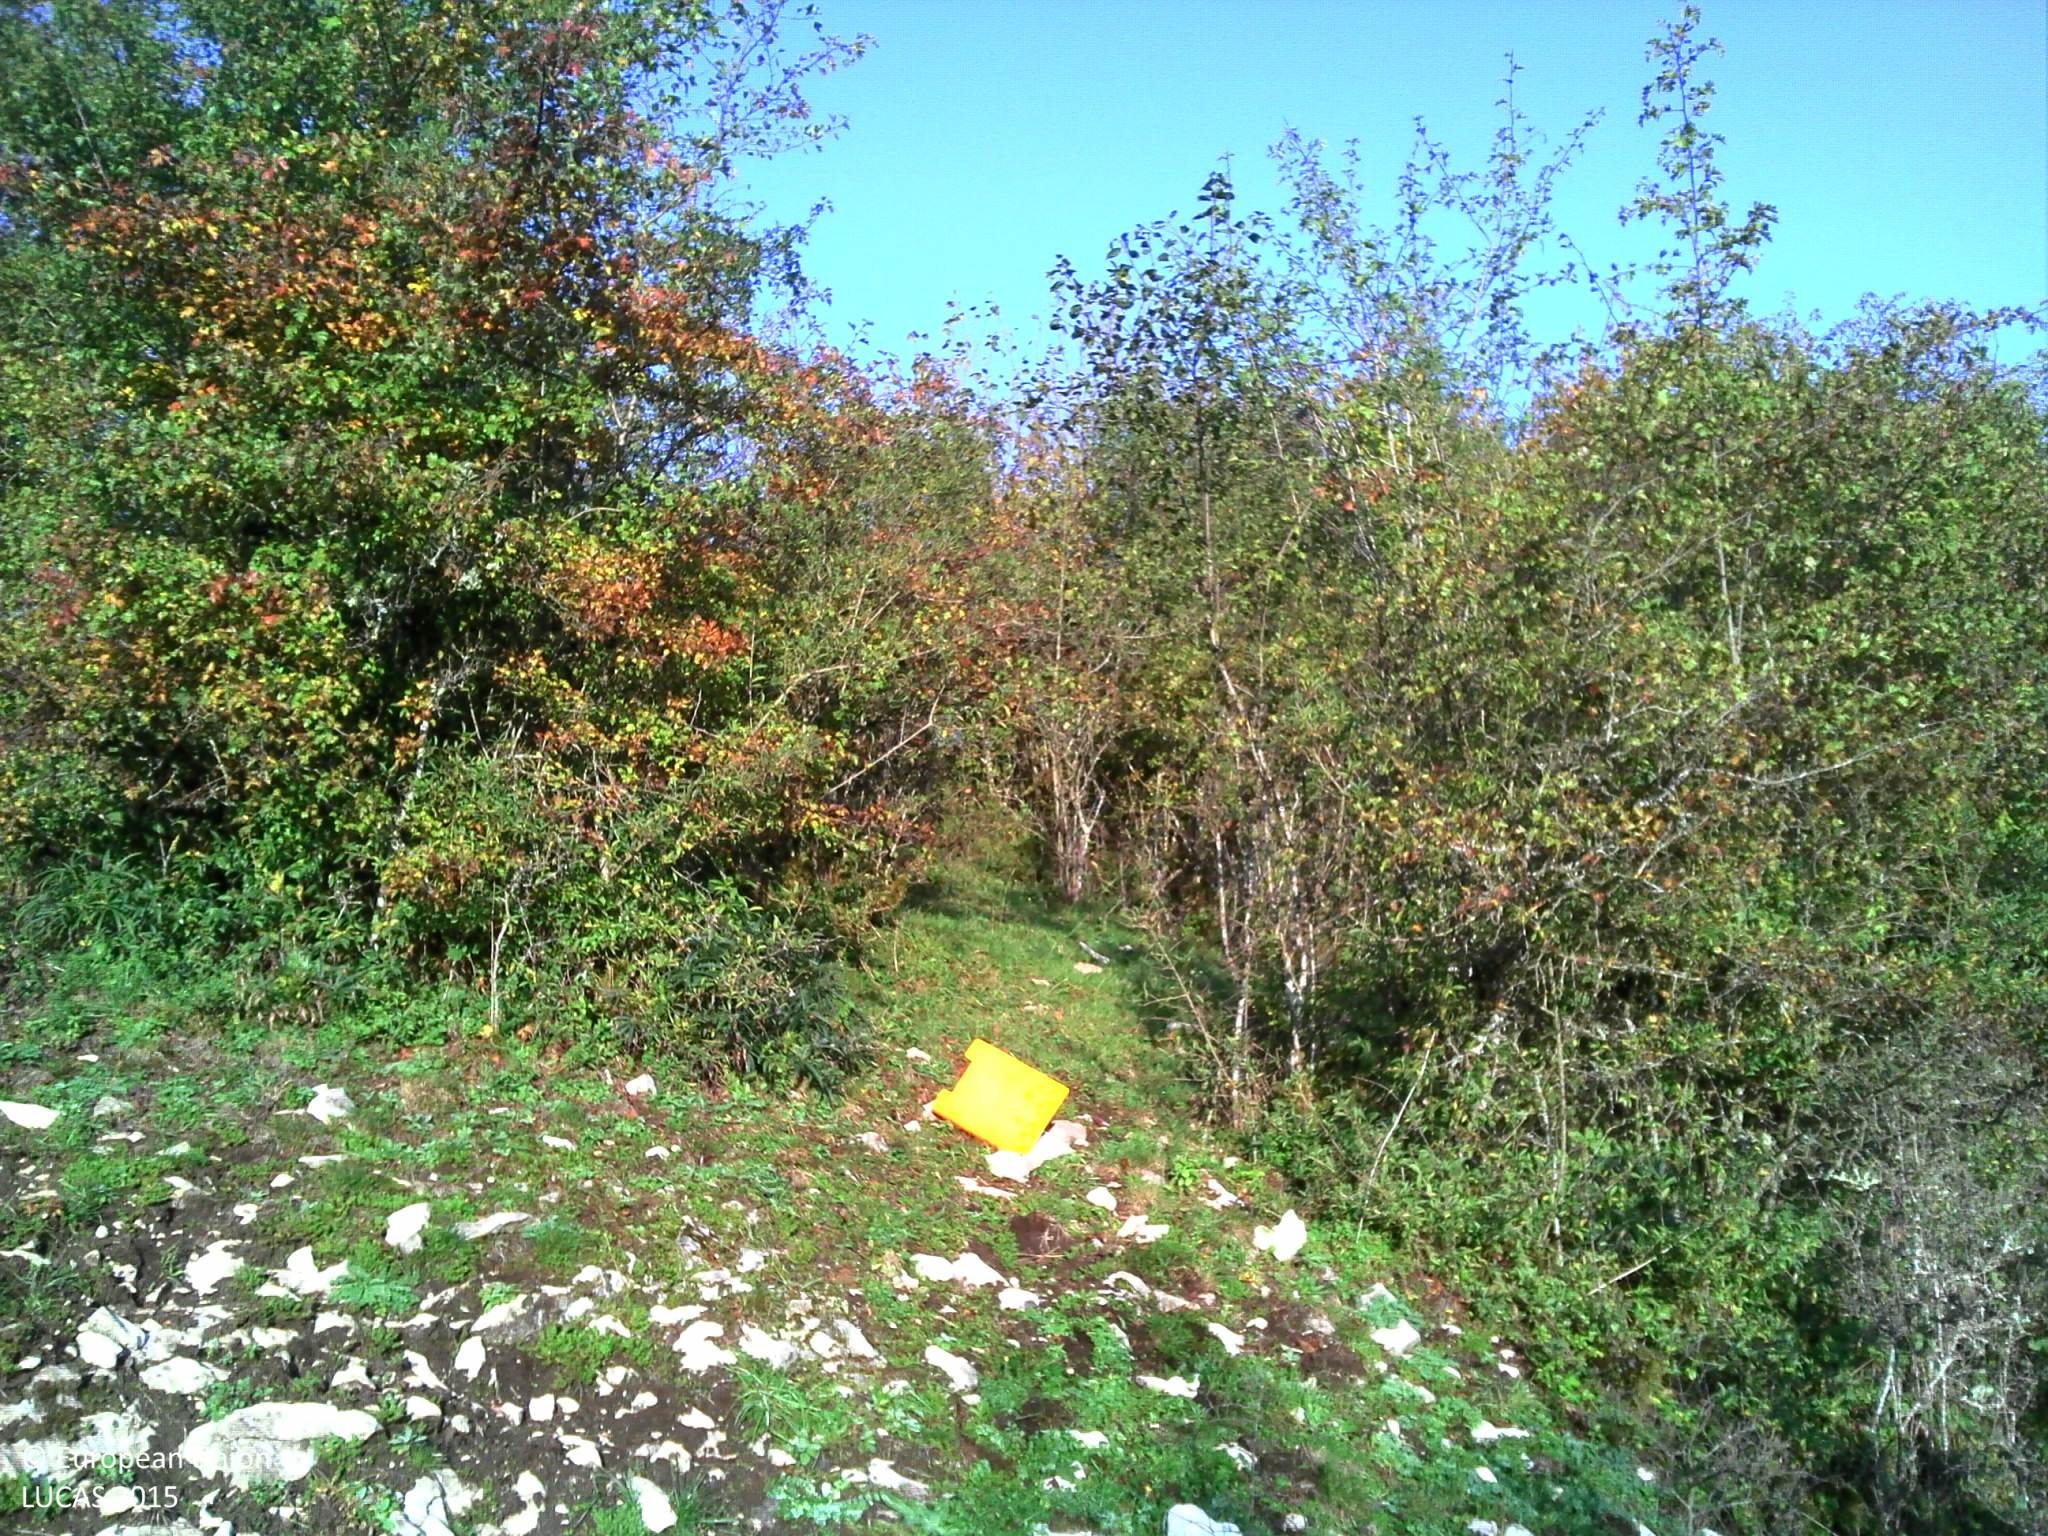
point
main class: Shrubland
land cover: Shrubland with sparse tree cover
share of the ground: > 75 %
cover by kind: shrubs 50 %, herbaceous plants 45 %, broadleaved forest trees 5 %
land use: Semi-natural and natural areas not in use
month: October
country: FR
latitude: 47.1610
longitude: 6.0315
